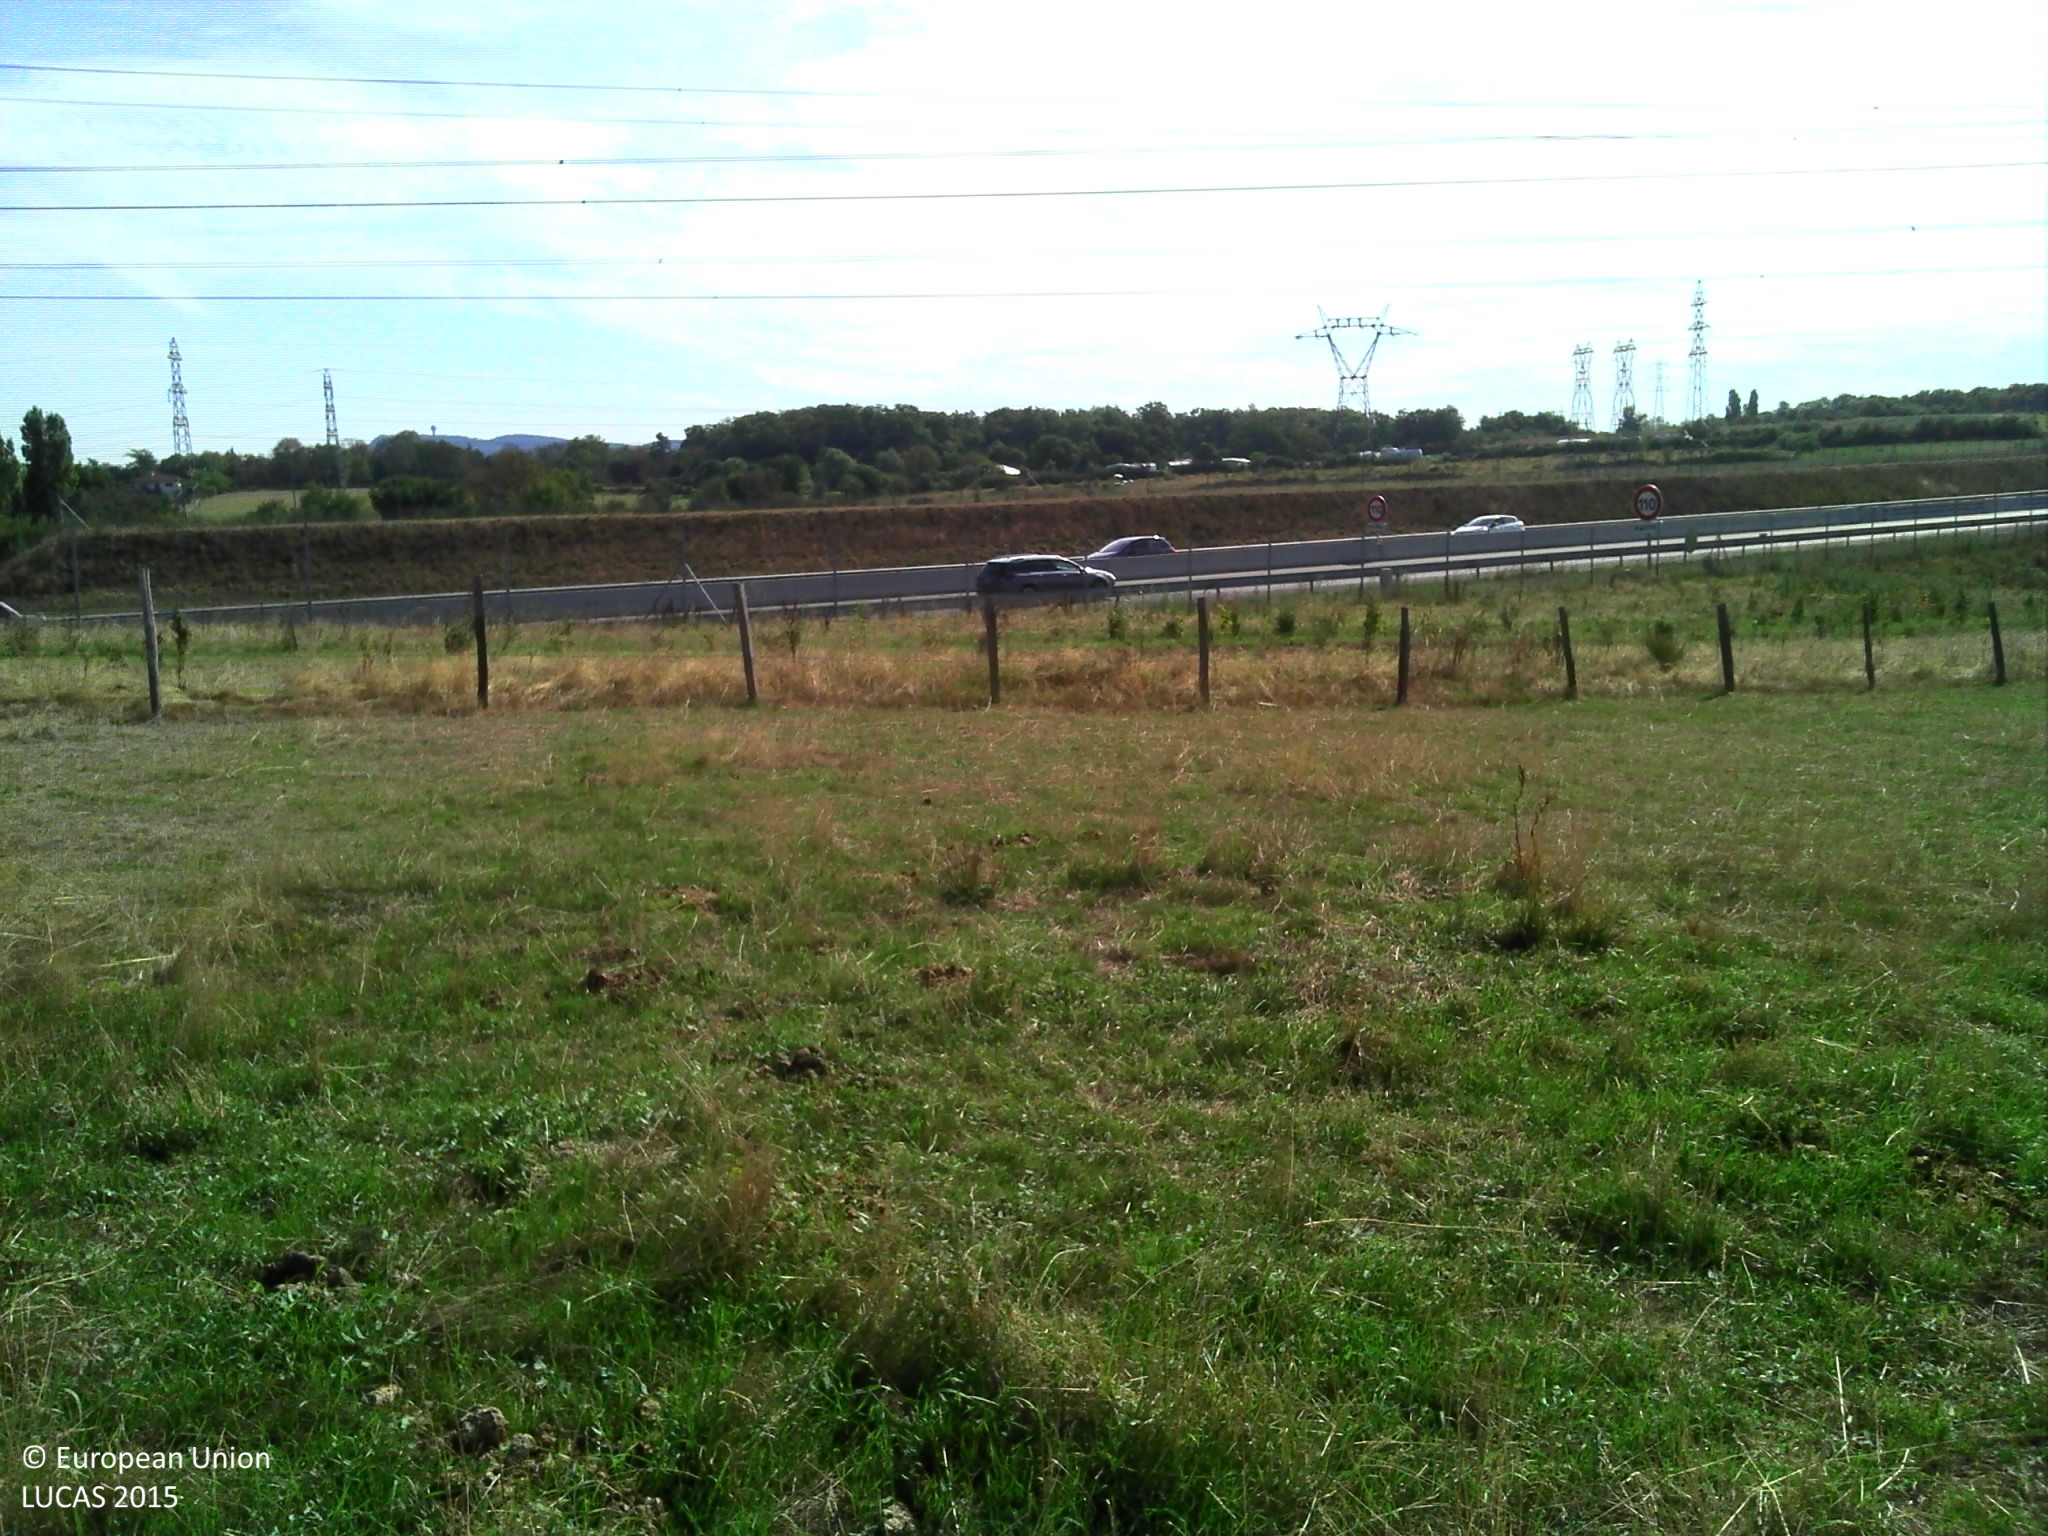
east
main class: Grassland
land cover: Grassland without tree/shrub cover
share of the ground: > 75 %
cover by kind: herbaceous plants 100 %
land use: Agriculture (excluding fallow land and kitchen gardens)
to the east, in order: Grassland without tree/shrub cover; Fences; Grassland without tree/shrub cover; Fences; Grass margins; Fences; Paved roads, cycling and walking lanes; Electric lines; Fences; Grass margins; Fences; Grassland without tree/shrub cover
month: August
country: FR
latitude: 45.8221
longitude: 4.6874
